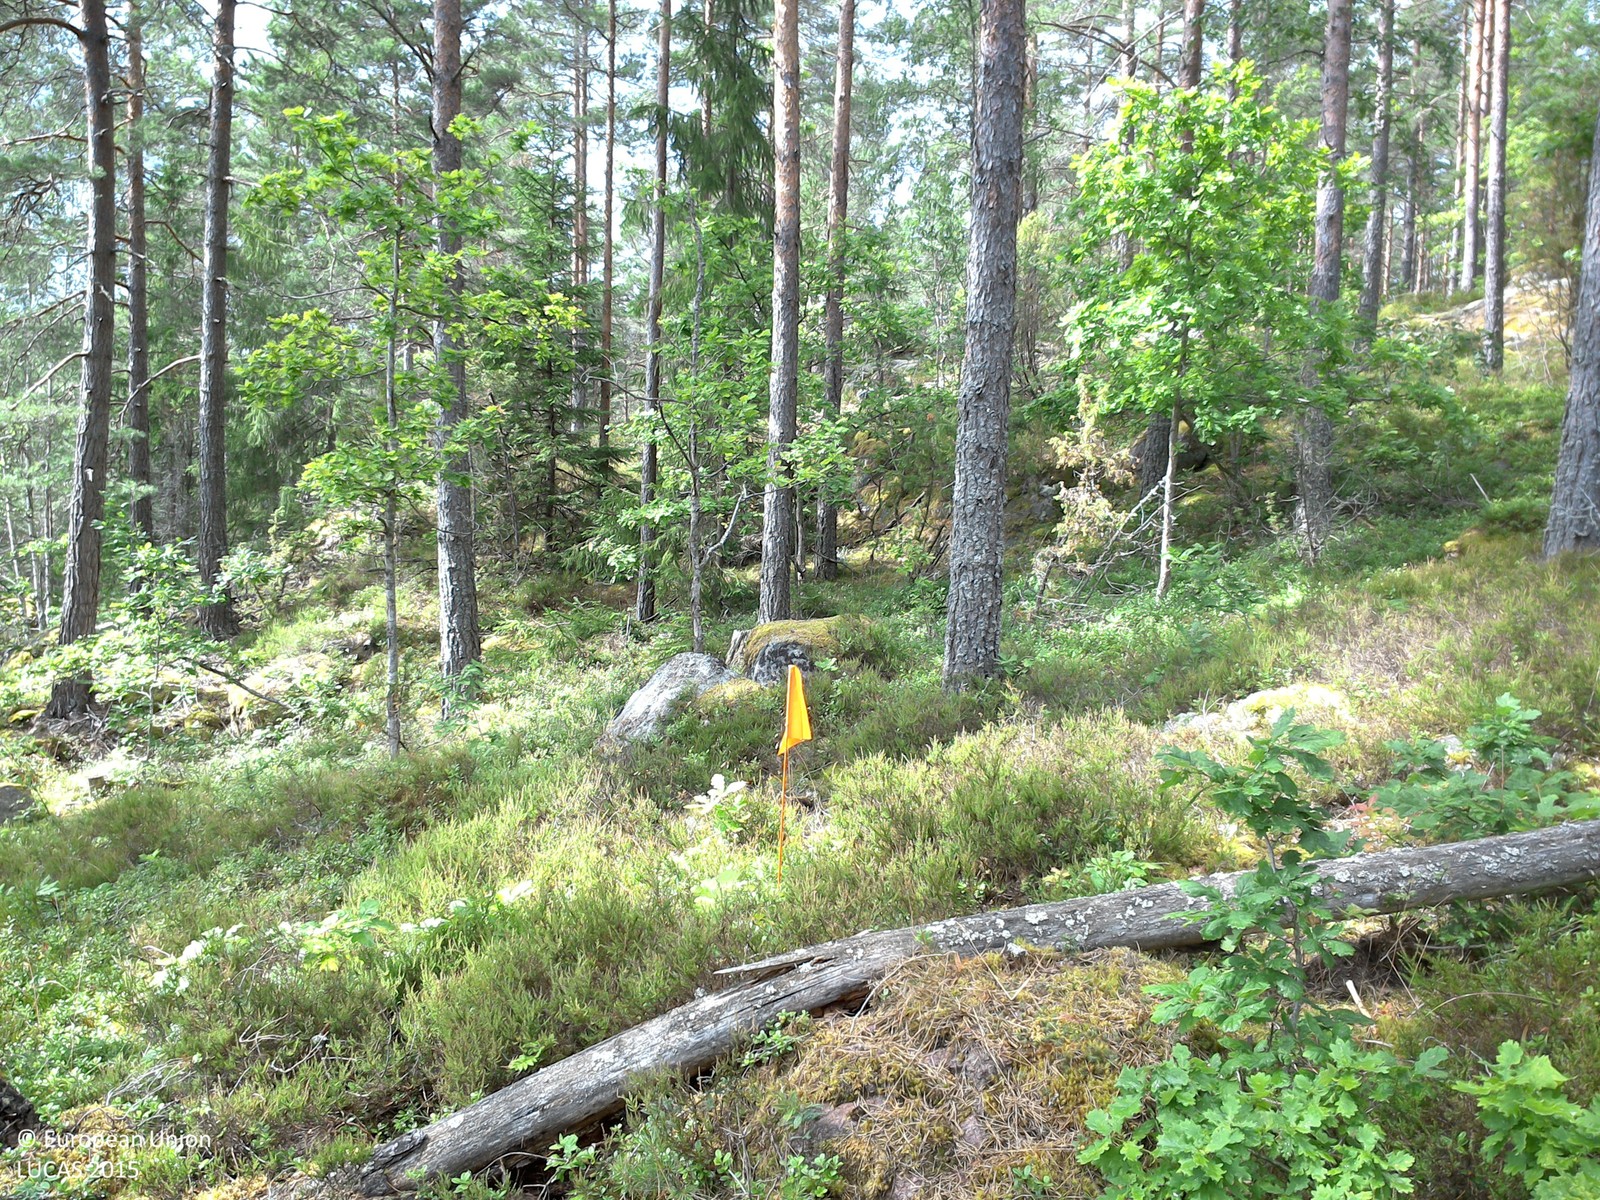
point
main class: Woodland
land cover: Pine dominated coniferous woodland
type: boreal forest
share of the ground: 50 - 75 %
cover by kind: coniferous forest trees 60 %, herbaceous plants 30 %, lichens and mosses 10 %
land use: Forestry
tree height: > 5 m
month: July
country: SE
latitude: 57.7400
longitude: 16.0613
